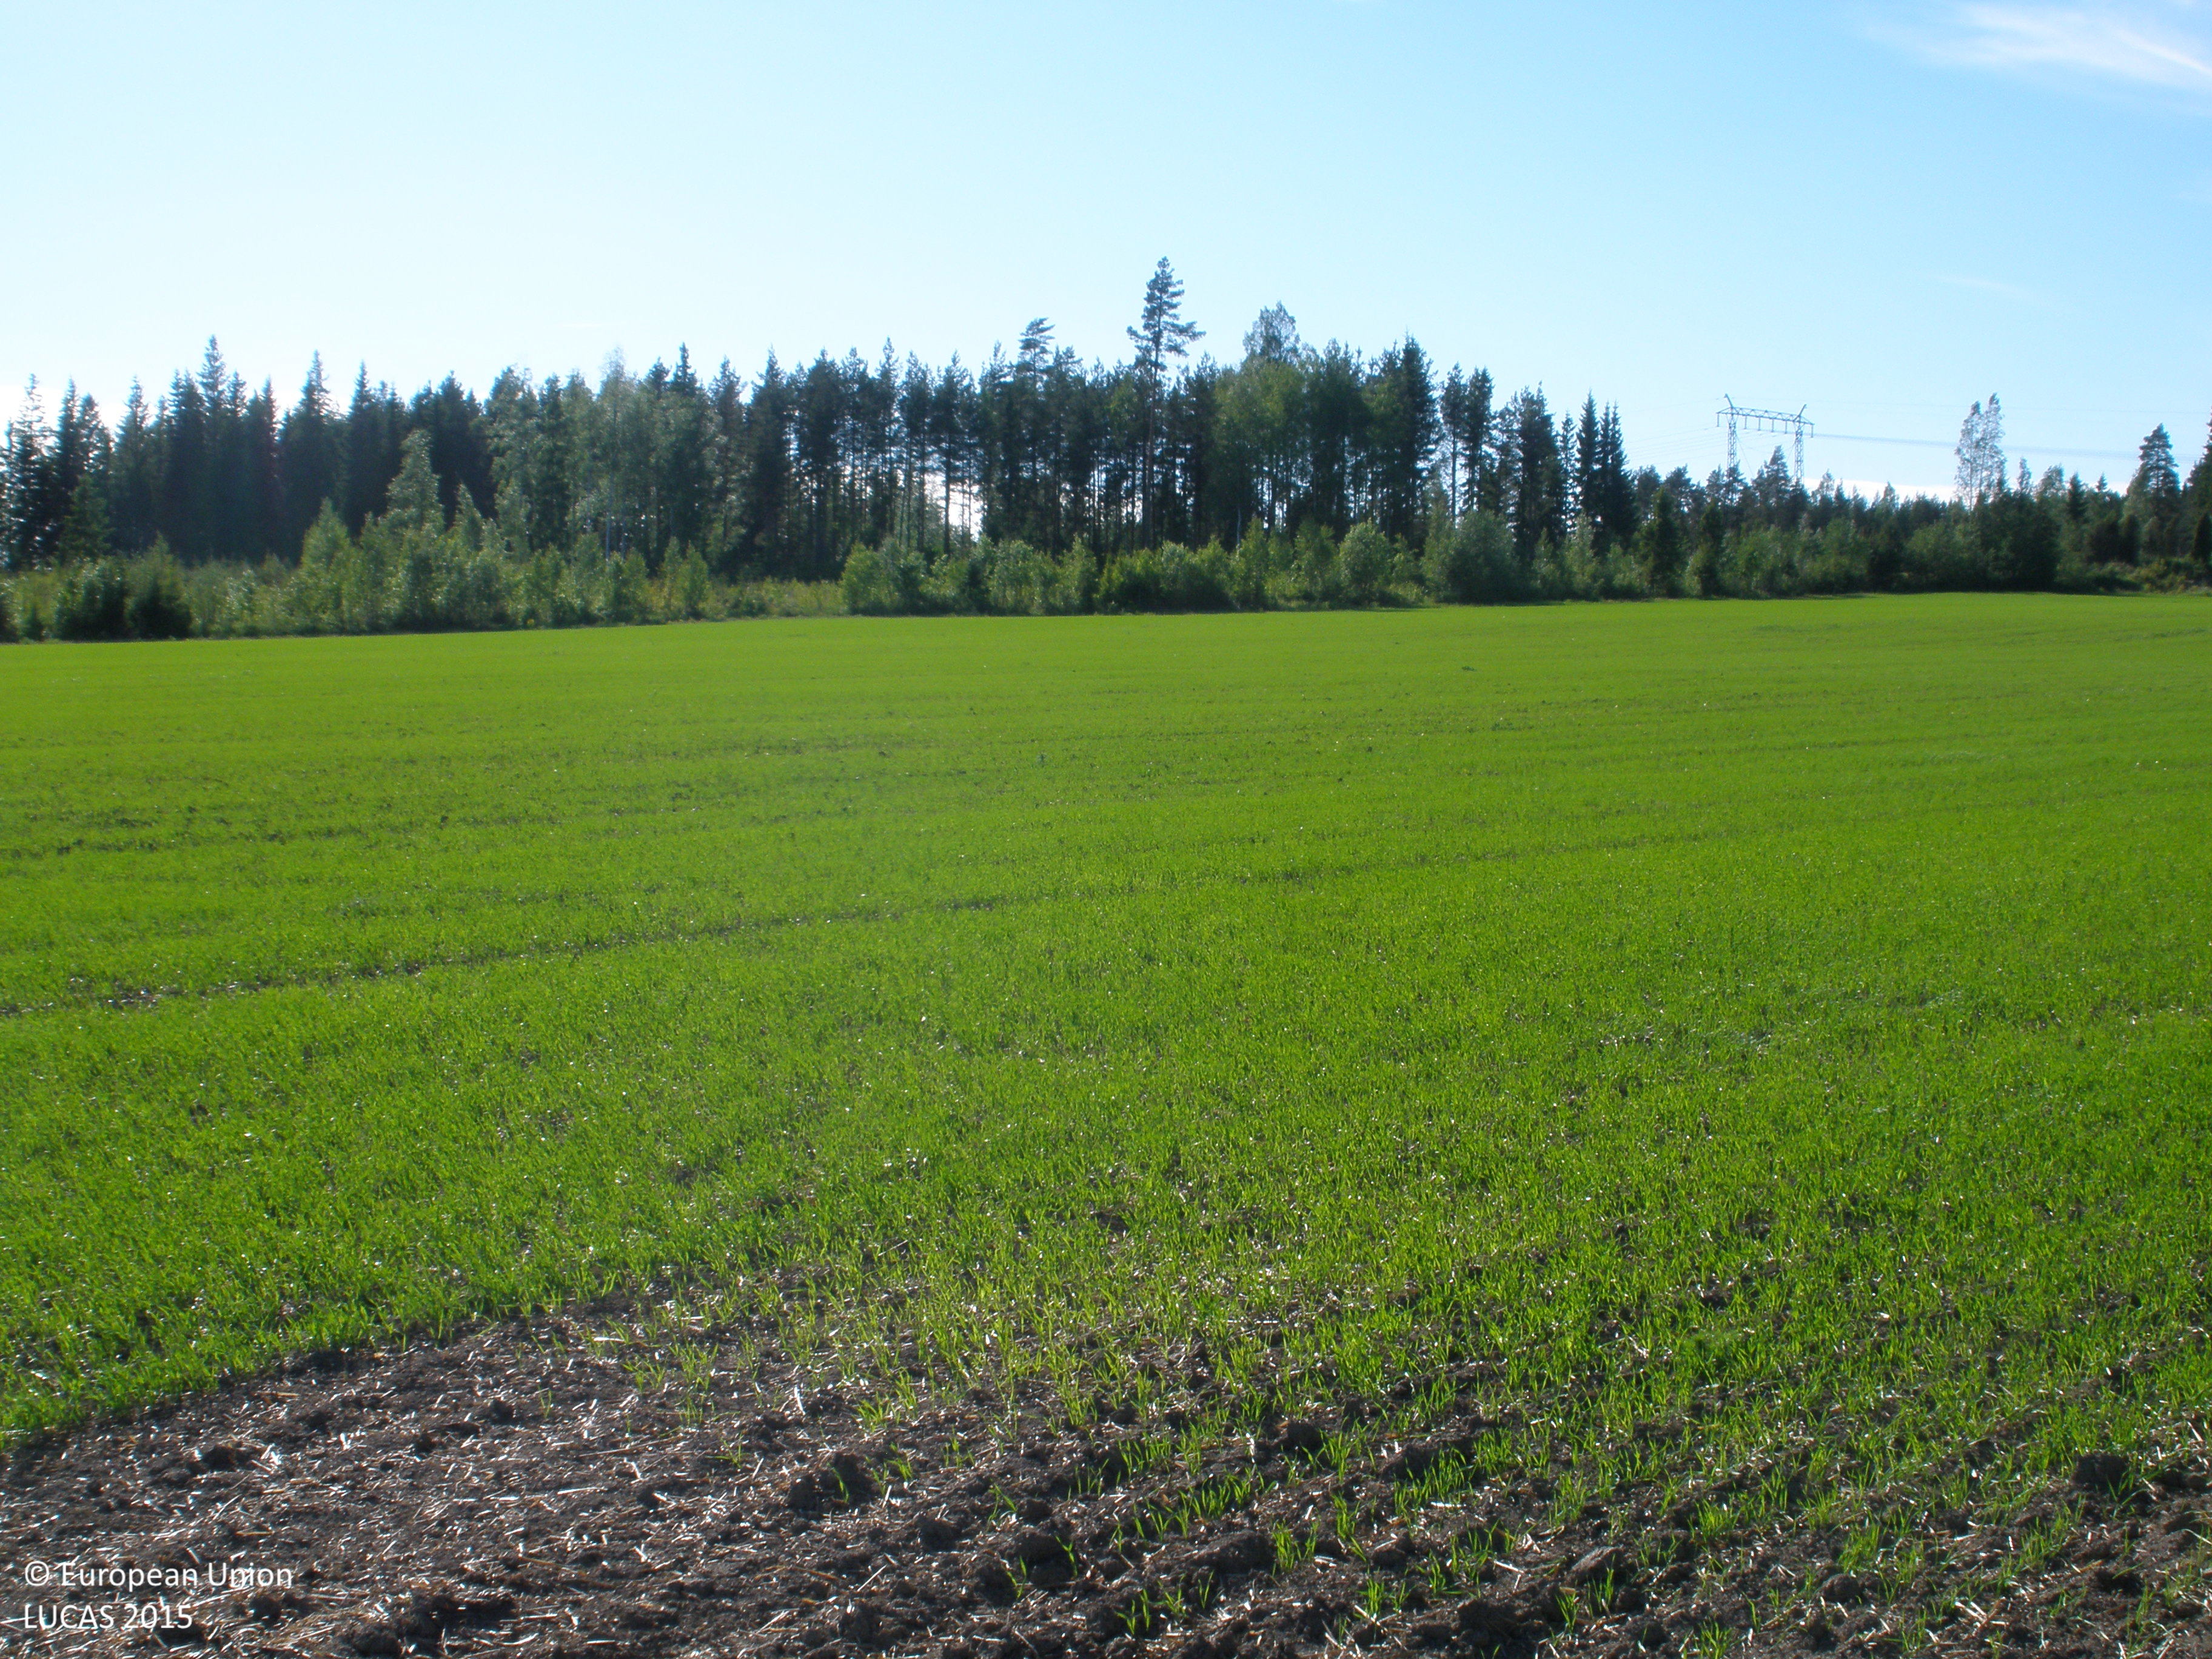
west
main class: Cropland
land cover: Common wheat
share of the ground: > 75 %
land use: Agriculture (excluding fallow land and kitchen gardens)
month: June
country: FI
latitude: 60.7613
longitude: 23.4264
